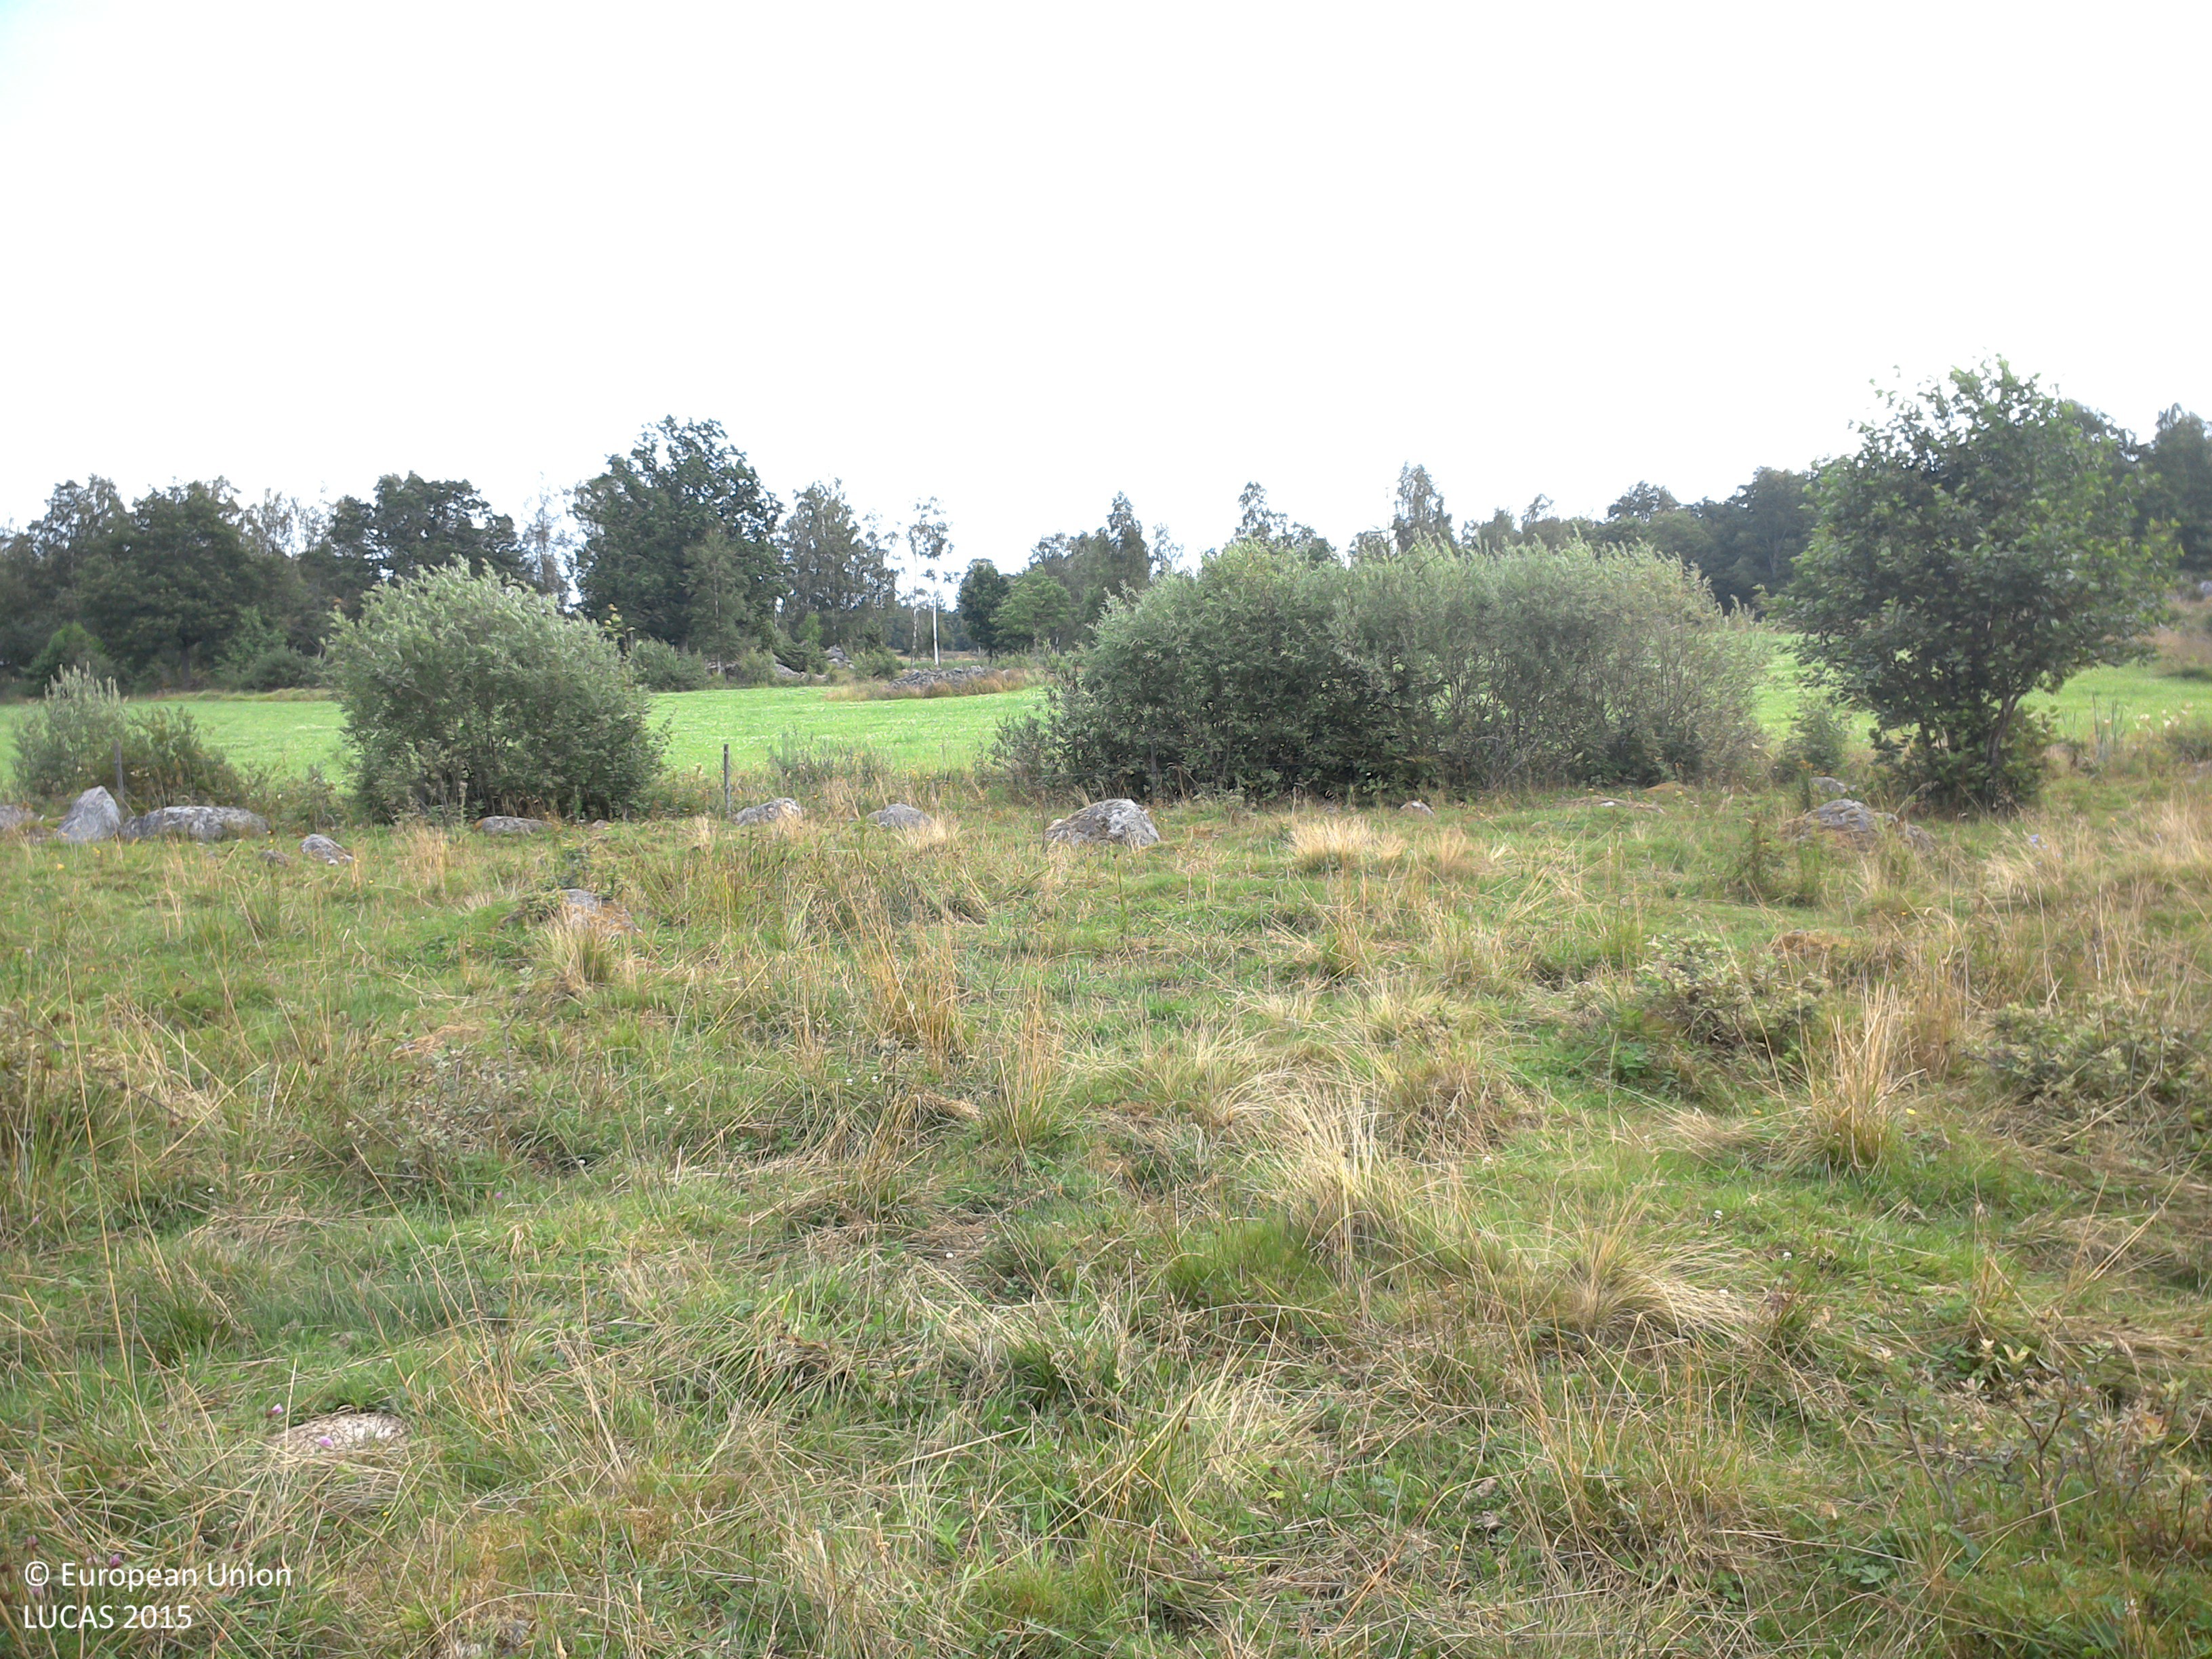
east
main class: Grassland
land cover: Grassland without tree/shrub cover
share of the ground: > 75 %
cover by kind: herbaceous plants 100 %
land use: Agriculture (excluding fallow land and kitchen gardens)
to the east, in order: Grassland without tree/shrub cover; Fences; Ditches and canals; Other leguminous and mixtures for fodder; Fences; Broadleaved woodland; Ditches and canals; Fences; Other leguminous and mixtures for fodder; Ditches and canals; Fences; Grassland with sparse tree/shrub cover
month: August
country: SE
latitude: 58.1900
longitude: 14.7400
